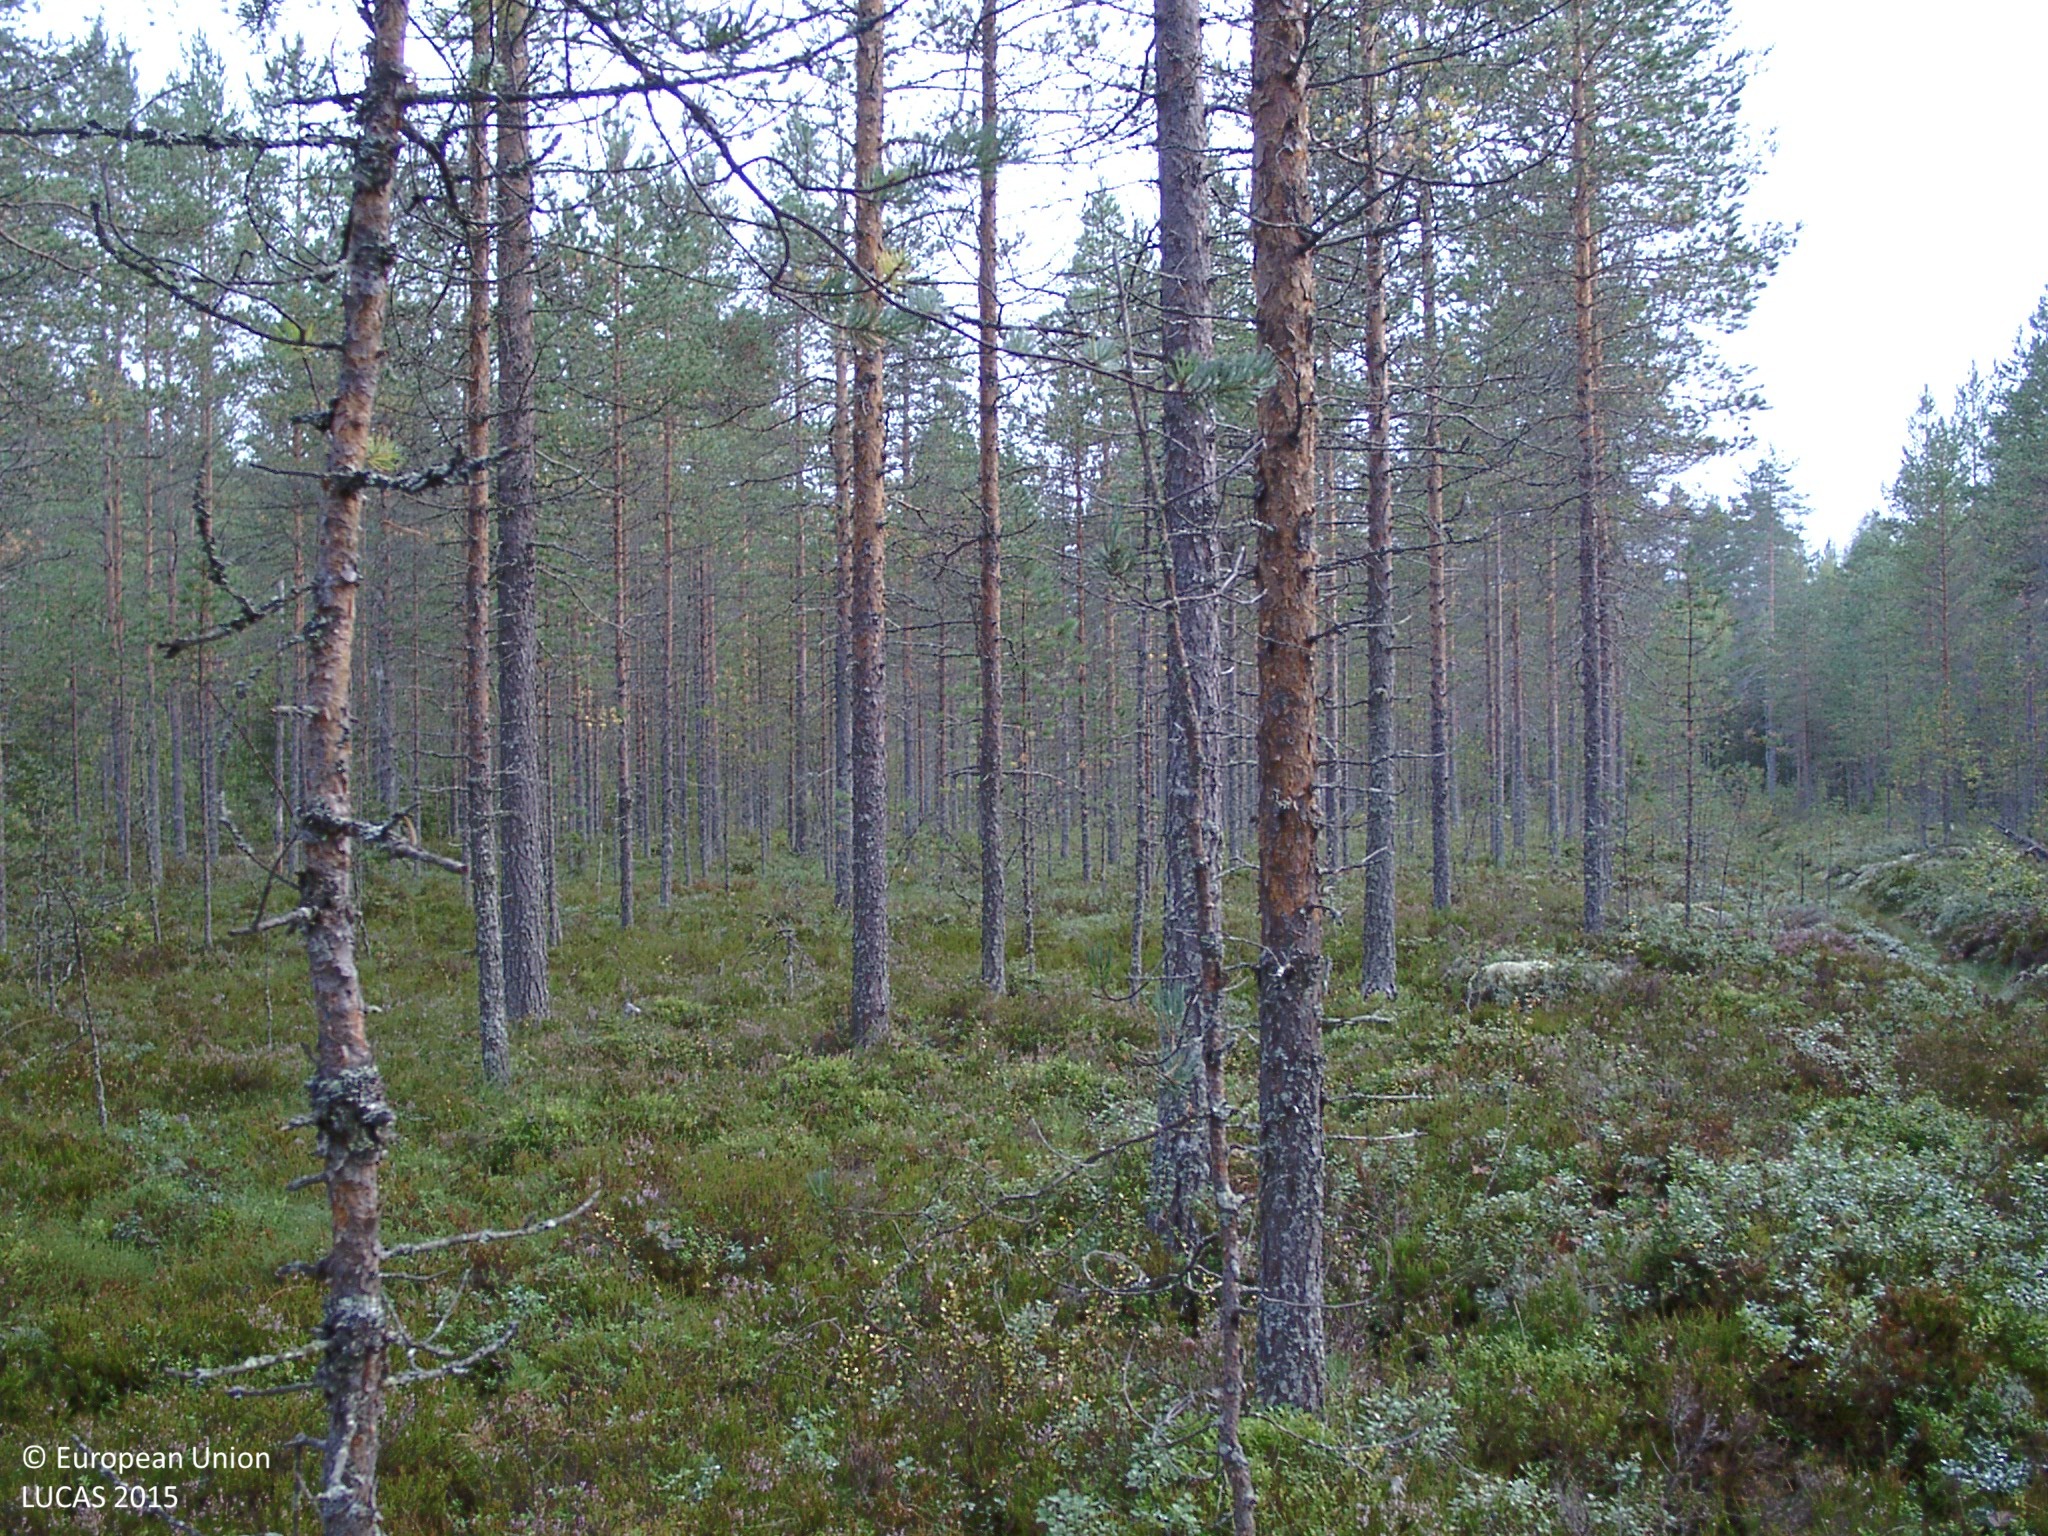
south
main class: Woodland
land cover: Pine dominated coniferous woodland
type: mire and swamp forests
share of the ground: 25 - 50 %
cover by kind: coniferous forest trees 40 %, shrubs 40 %, lichens and mosses 15 %, herbaceous plants 5 %
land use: Forestry
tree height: > 5 m
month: August
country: FI
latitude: 62.3952
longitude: 24.9373
